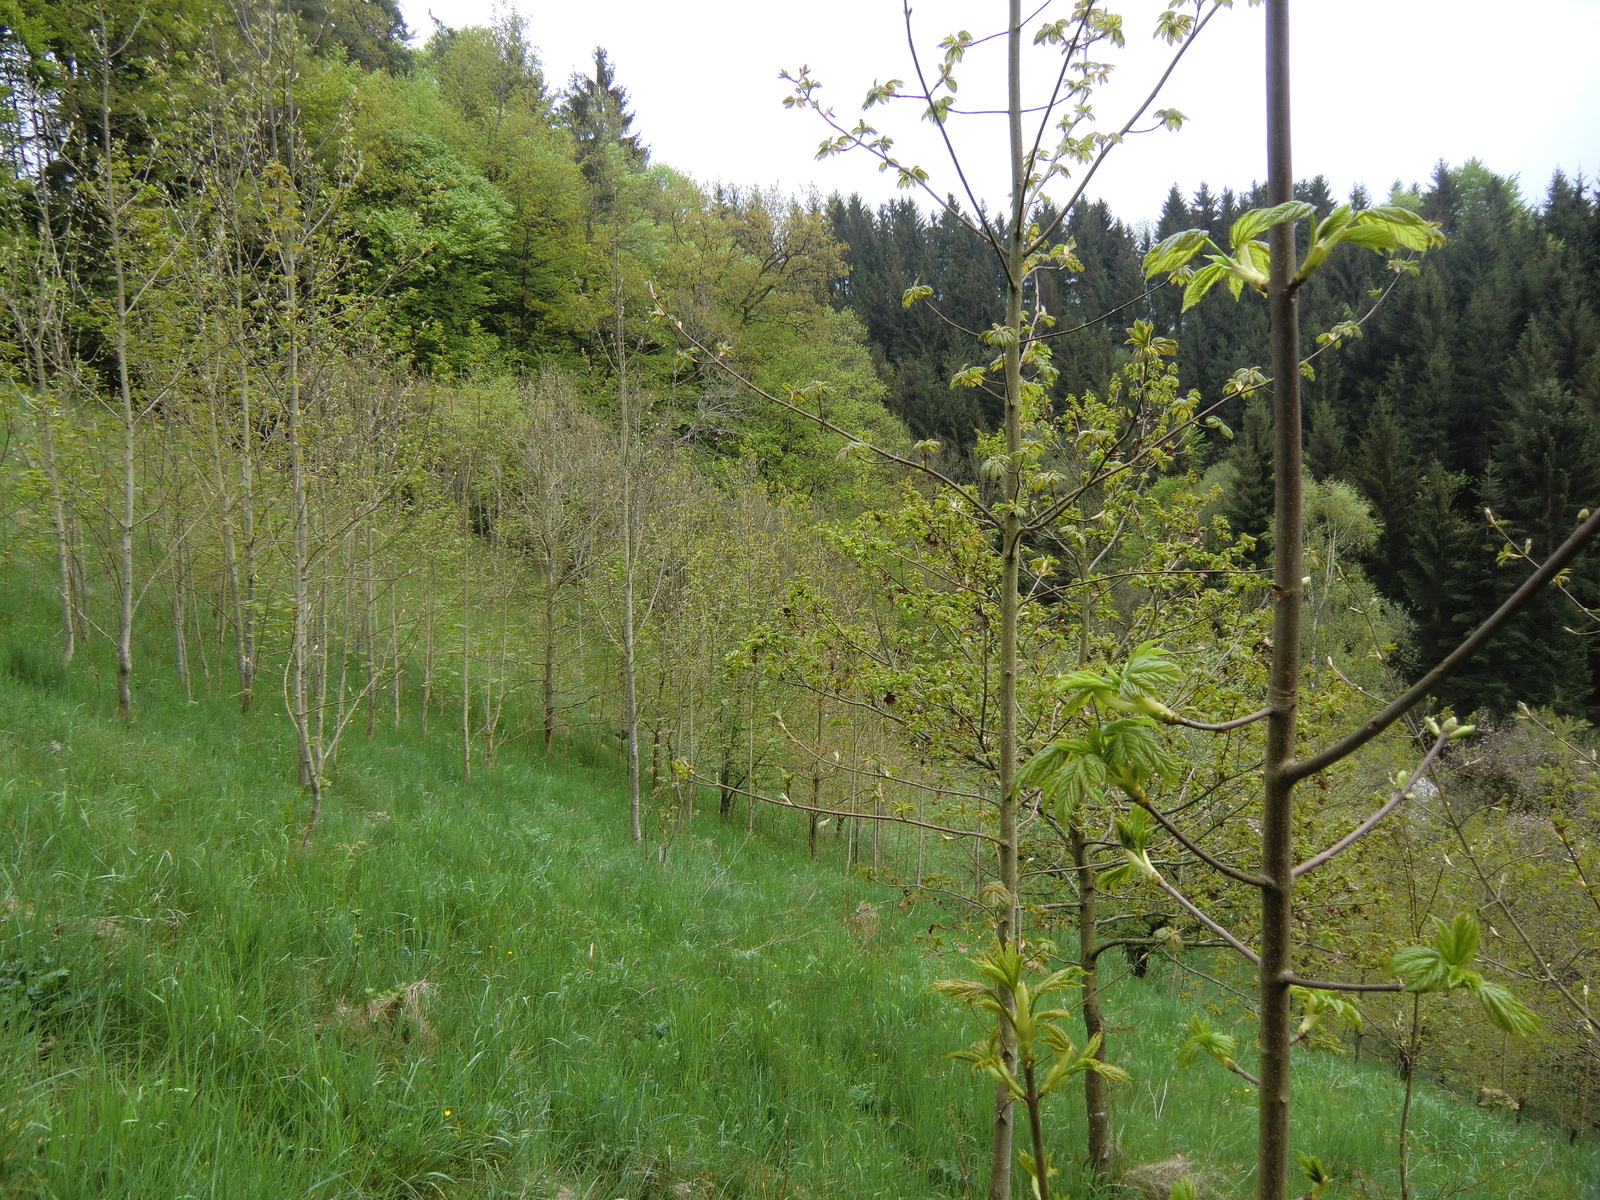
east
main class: Woodland
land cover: Broadleaved woodland
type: non-riverine alder, birch or aspen forest
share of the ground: 10 - 25 %
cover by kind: herbaceous plants 75 %, broadleaved forest trees 25 %
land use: Forestry
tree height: < 5 m
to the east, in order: Broadleaved woodland; Grassland without tree/shrub cover; Shrubland with sparse tree cover; Other mixed woodland; Tracks; Electric lines; Grassland without tree/shrub cover; Other mixed woodland; Inland fresh running water; Broadleaved woodland; Tracks; Spruce dominated coniferous woodland; Tracks; Shrubland without tree cover; Fences; Other mixed woodland; Fences; Grass margins; Barley
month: May
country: AT
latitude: 48.2999
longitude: 14.7866
